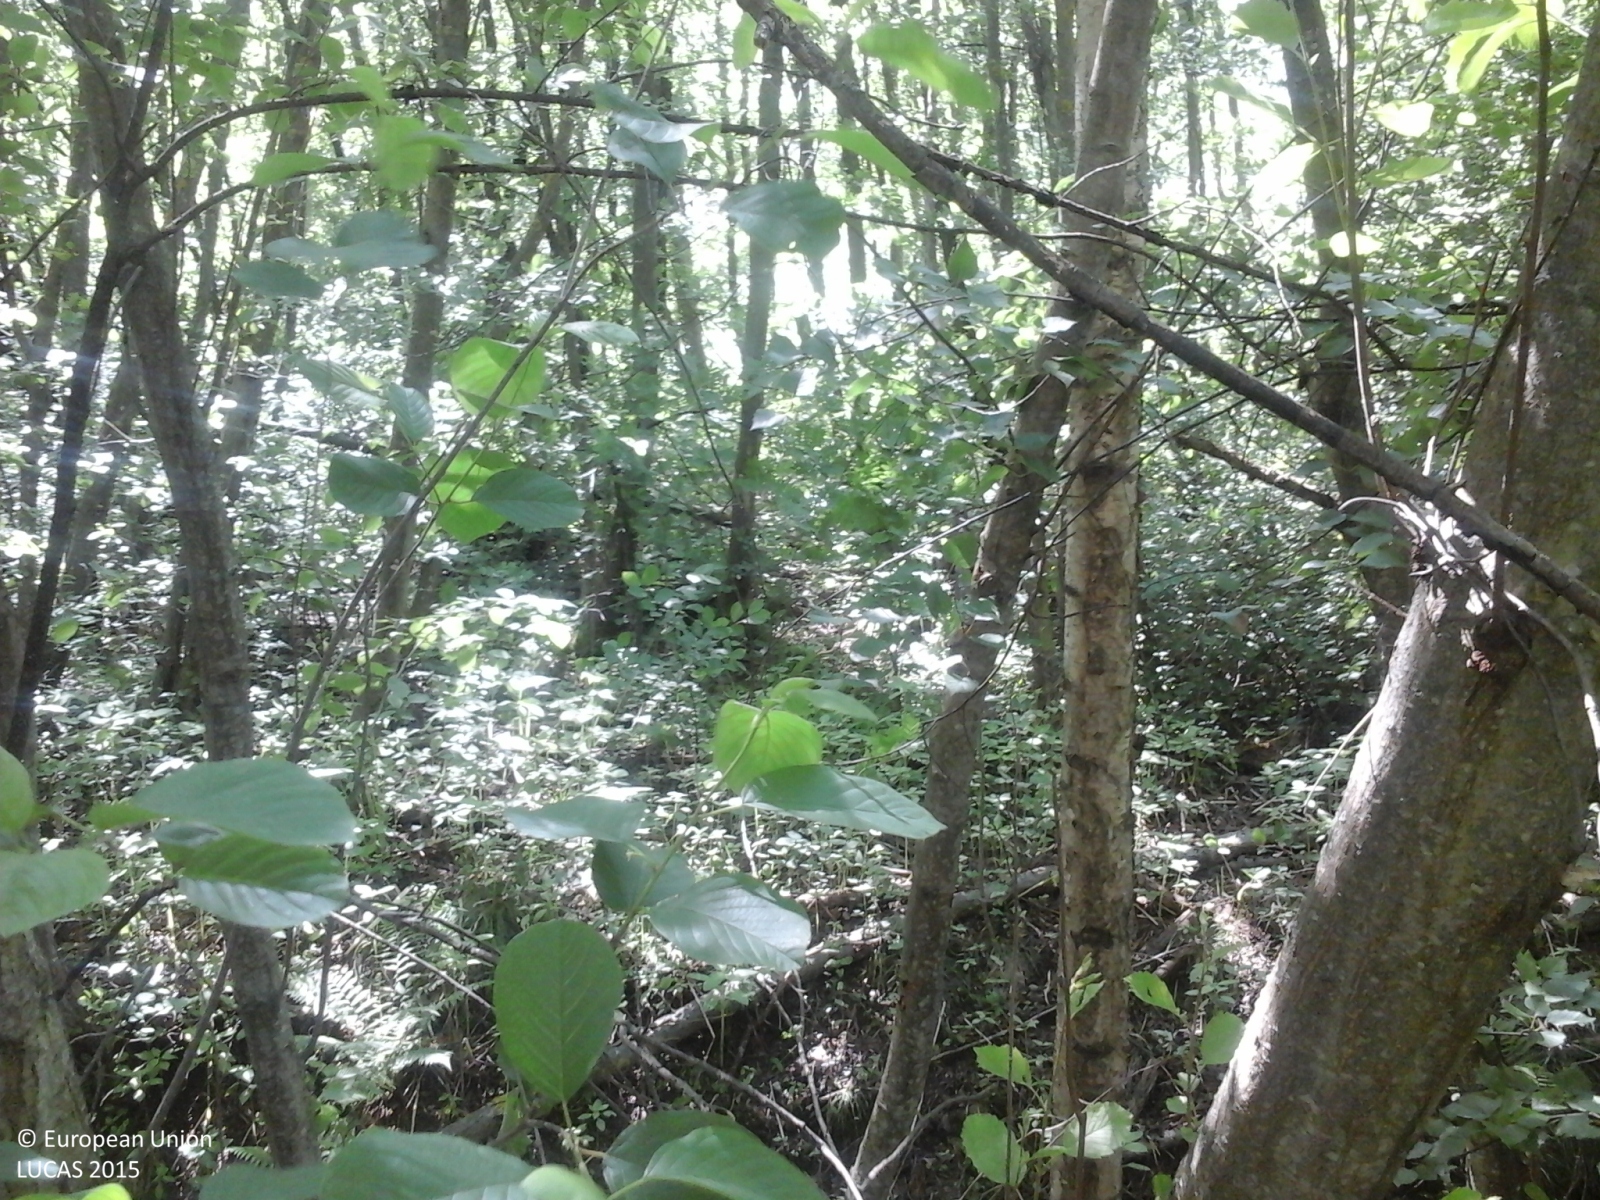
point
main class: Woodland
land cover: Broadleaved woodland
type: mesophytic deciduous forest
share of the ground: > 75 %
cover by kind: broadleaved forest trees 100 %
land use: Forestry
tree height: > 5 m
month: May
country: IT
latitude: 46.6195
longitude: 10.6391
